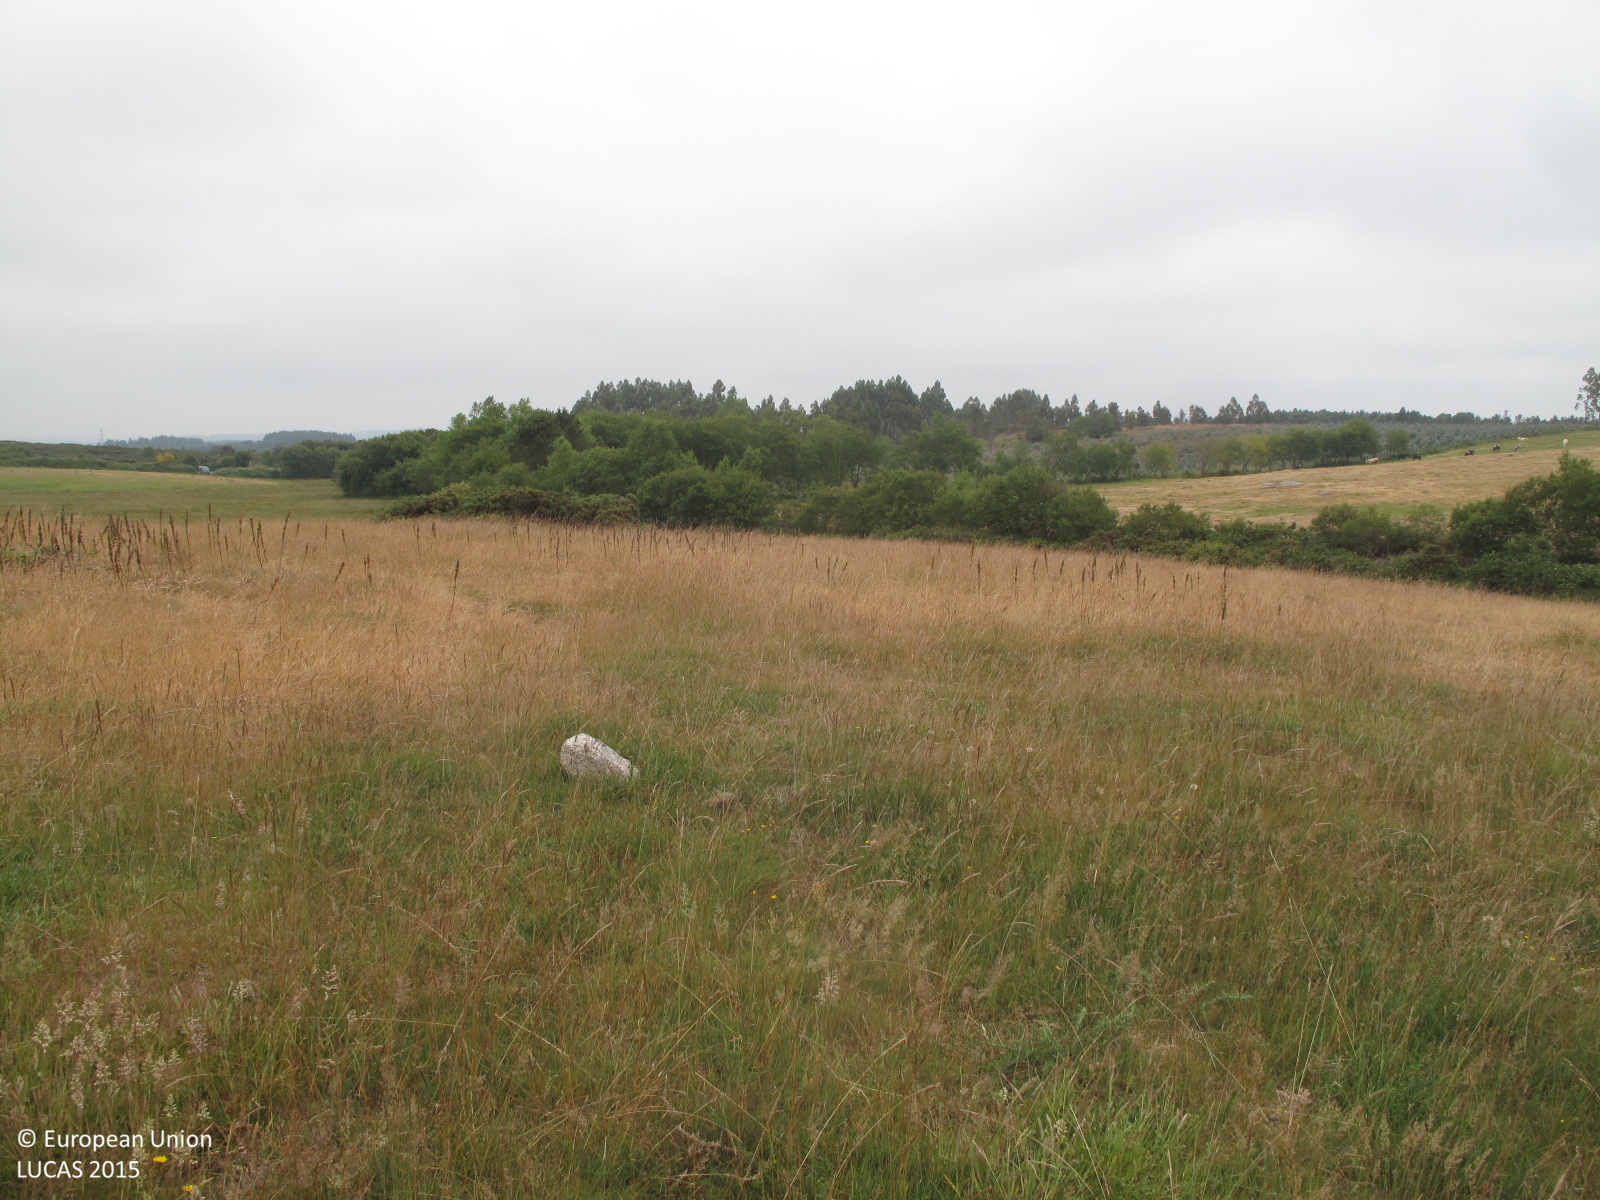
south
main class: Shrubland
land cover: Shrubland without tree cover
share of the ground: 10 - 25 %
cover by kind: herbaceous plants 90 %, shrubs 10 %
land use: Agriculture (excluding fallow land and kitchen gardens)
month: June
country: ES
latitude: 43.1860
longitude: -8.0957
